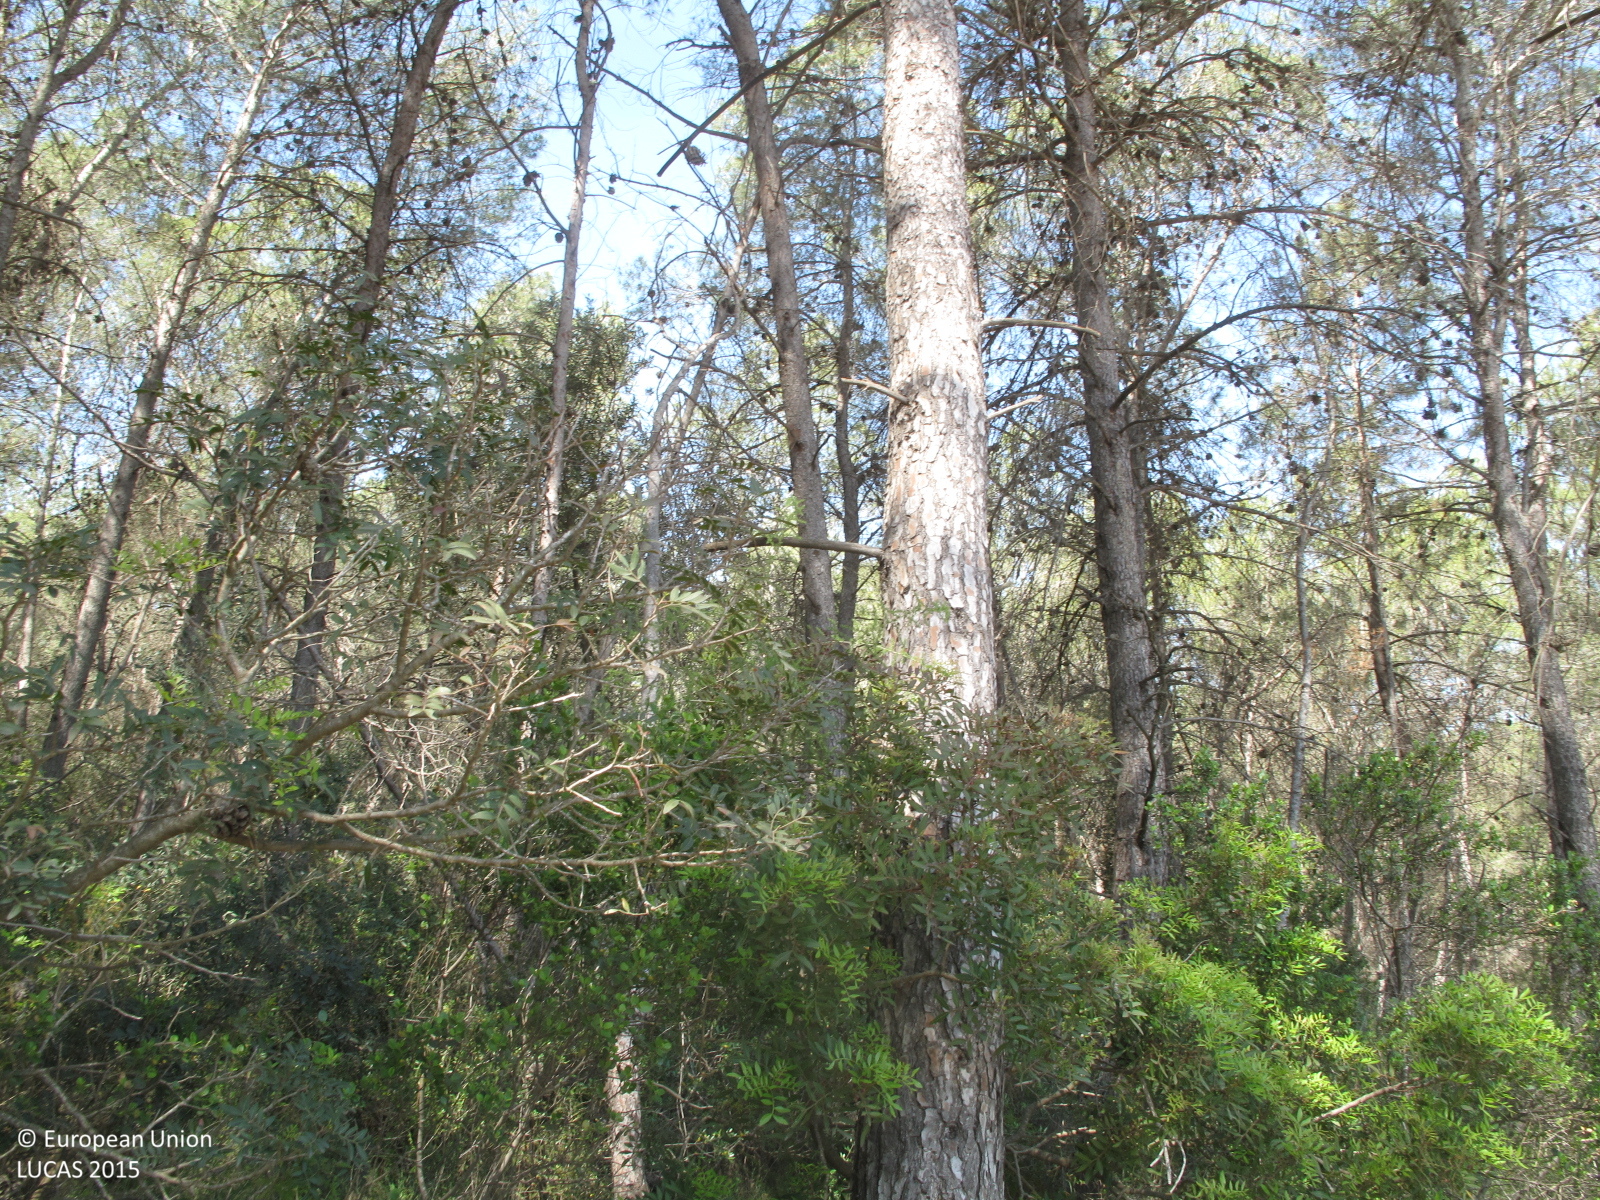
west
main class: Woodland
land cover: Pine dominated coniferous woodland
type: coniferous forest of the mediterranean region
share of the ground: > 75 %
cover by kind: coniferous forest trees 90 %, shrubs 10 %
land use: Semi-natural and natural areas not in use
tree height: > 5 m
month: May
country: ES
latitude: 38.9489
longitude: -0.5500
